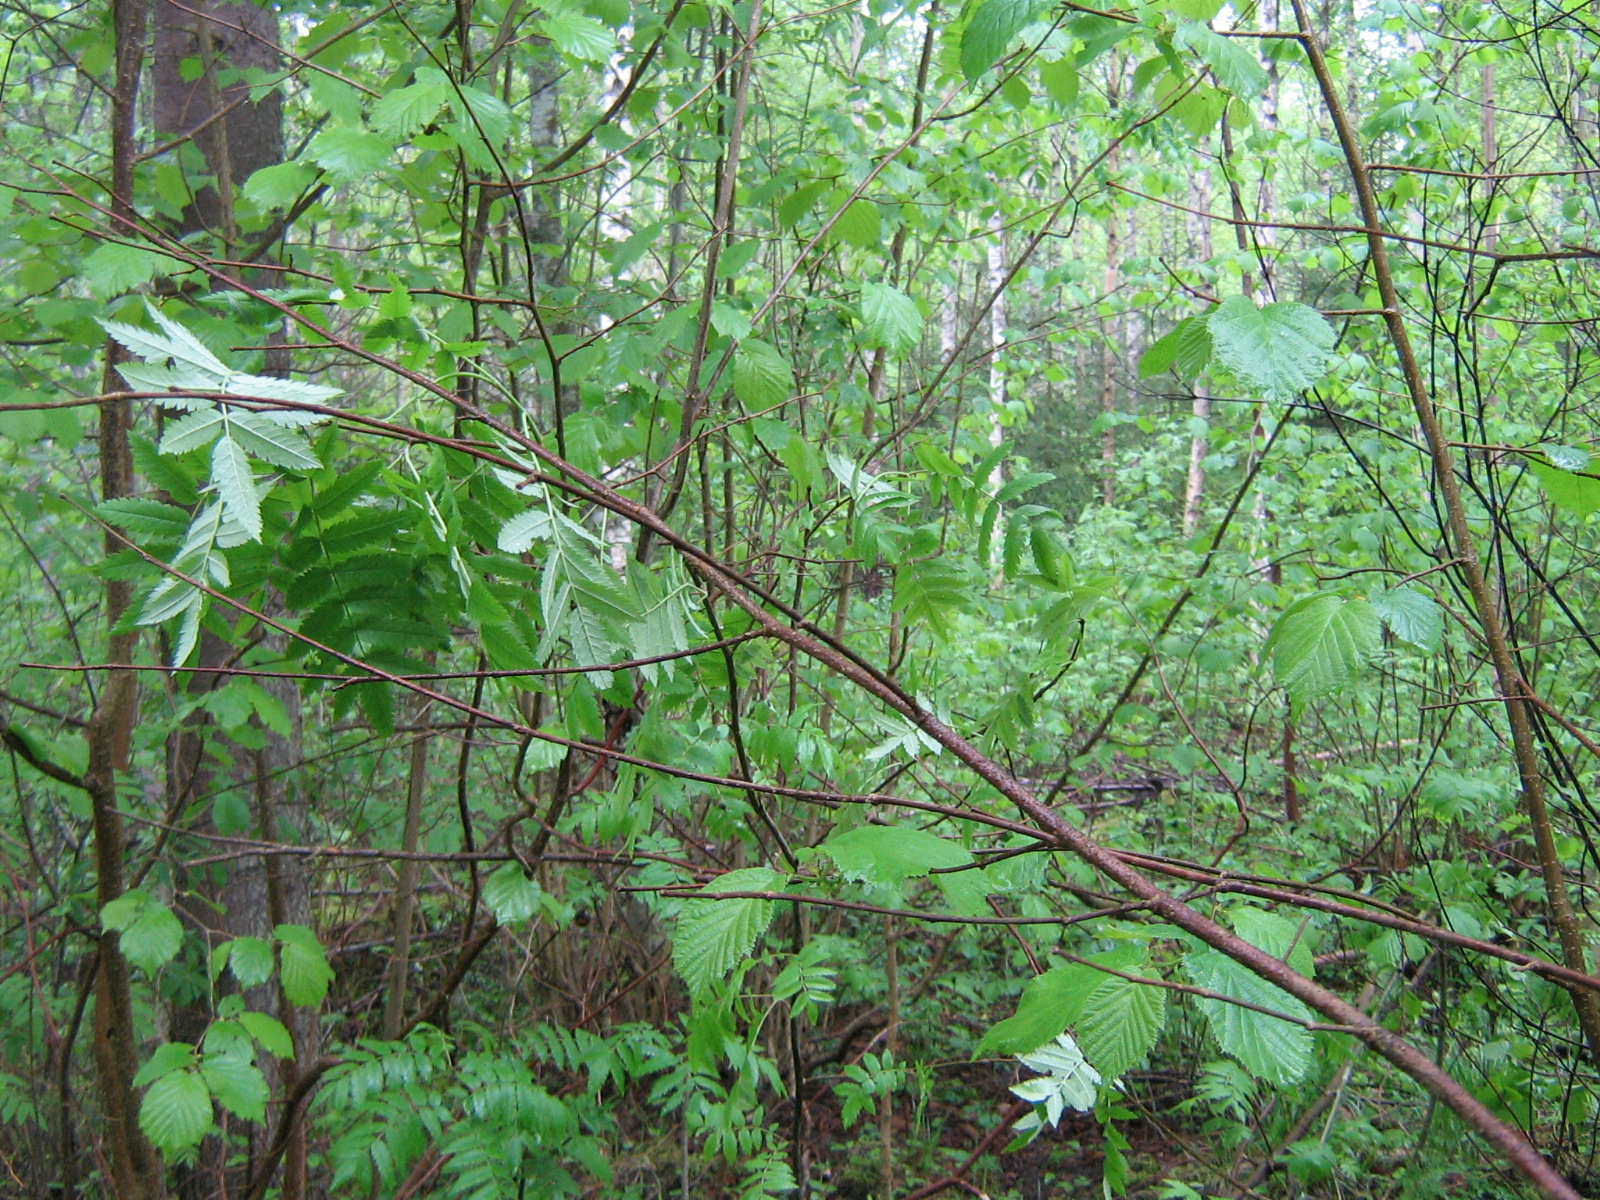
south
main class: Woodland
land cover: Broadleaved woodland
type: non-riverine alder, birch or aspen forest
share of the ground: > 75 %
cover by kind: broadleaved forest trees 100 %
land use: Semi-natural and natural areas not in use
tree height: > 5 m
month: May
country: LV
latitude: 57.3380
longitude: 25.8927
